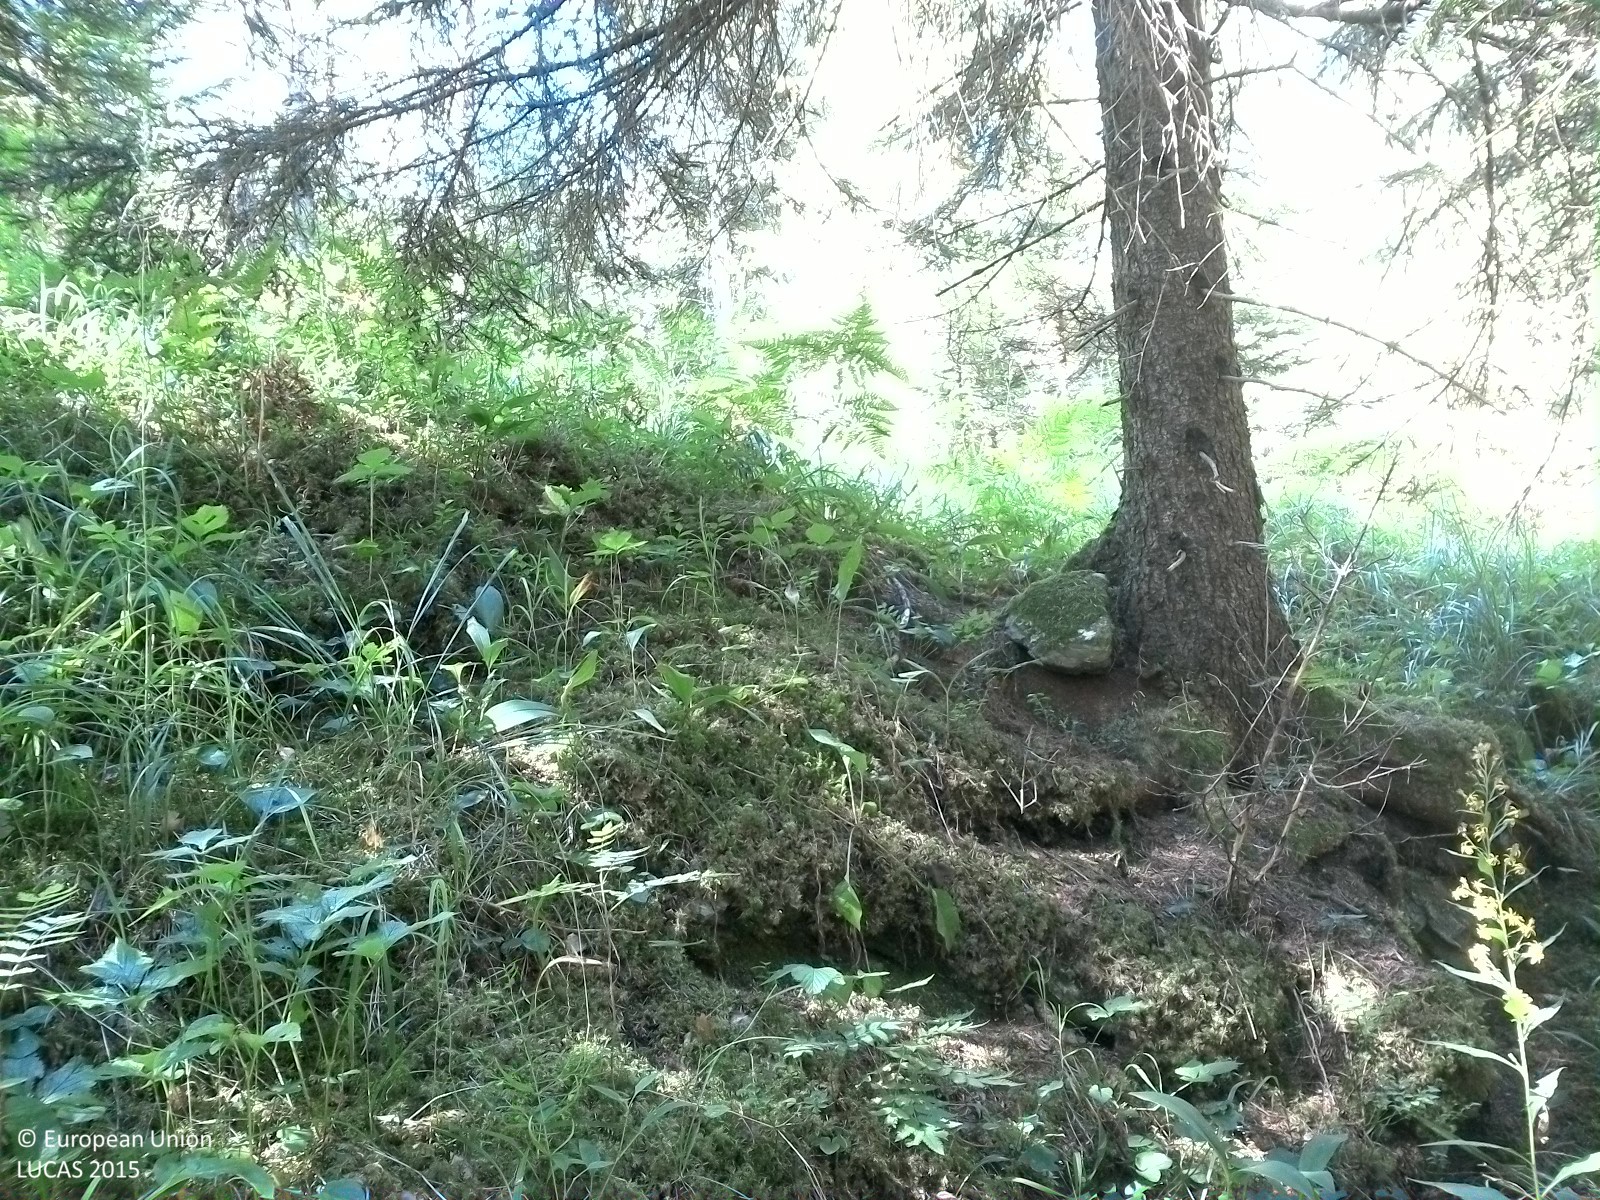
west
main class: Woodland
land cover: Spruce dominated coniferous woodland
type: boreal forest
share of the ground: 50 - 75 %
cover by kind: coniferous forest trees 60 %, herbaceous plants 20 %, lichens and mosses 20 %
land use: Forestry
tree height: > 5 m
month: August
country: SE
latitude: 59.4149
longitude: 14.7661
